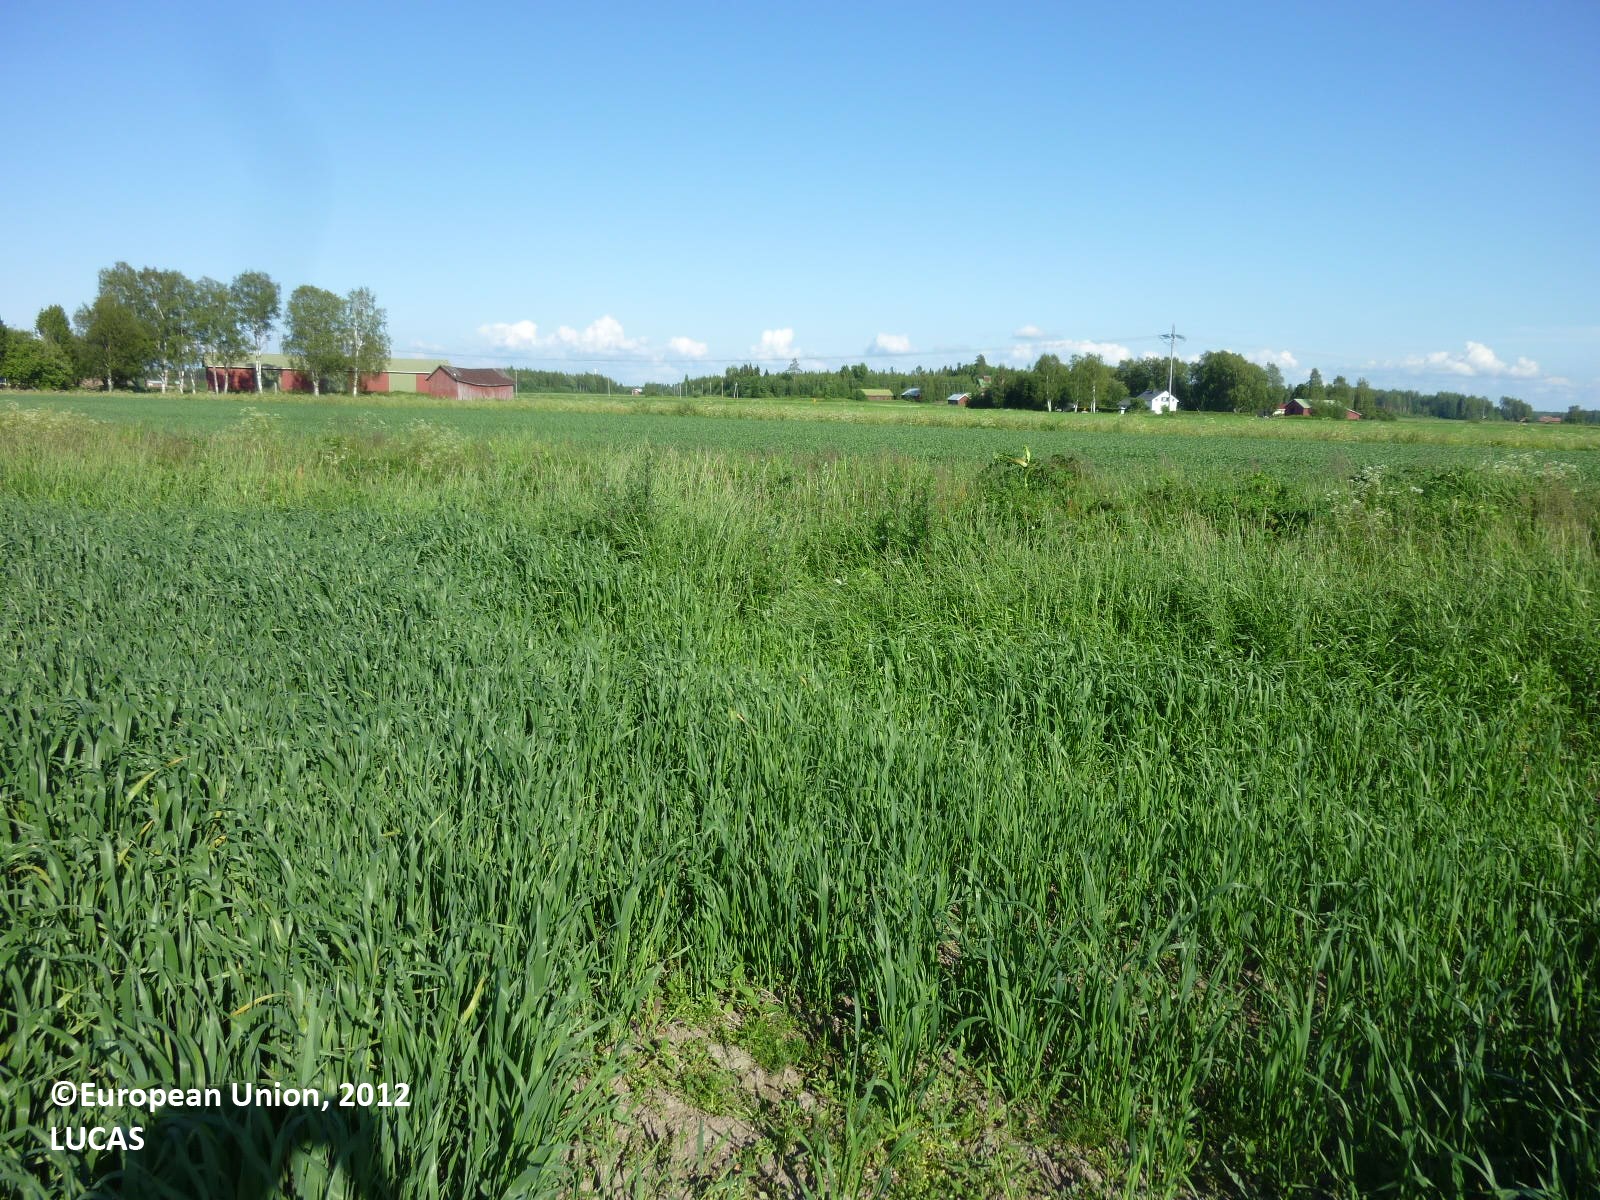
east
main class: Cropland
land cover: Oats
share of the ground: > 75 %
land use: Agriculture (excluding fallow land and kitchen gardens)
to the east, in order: Oats
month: July
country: FI
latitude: 61.3271
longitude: 21.9963
